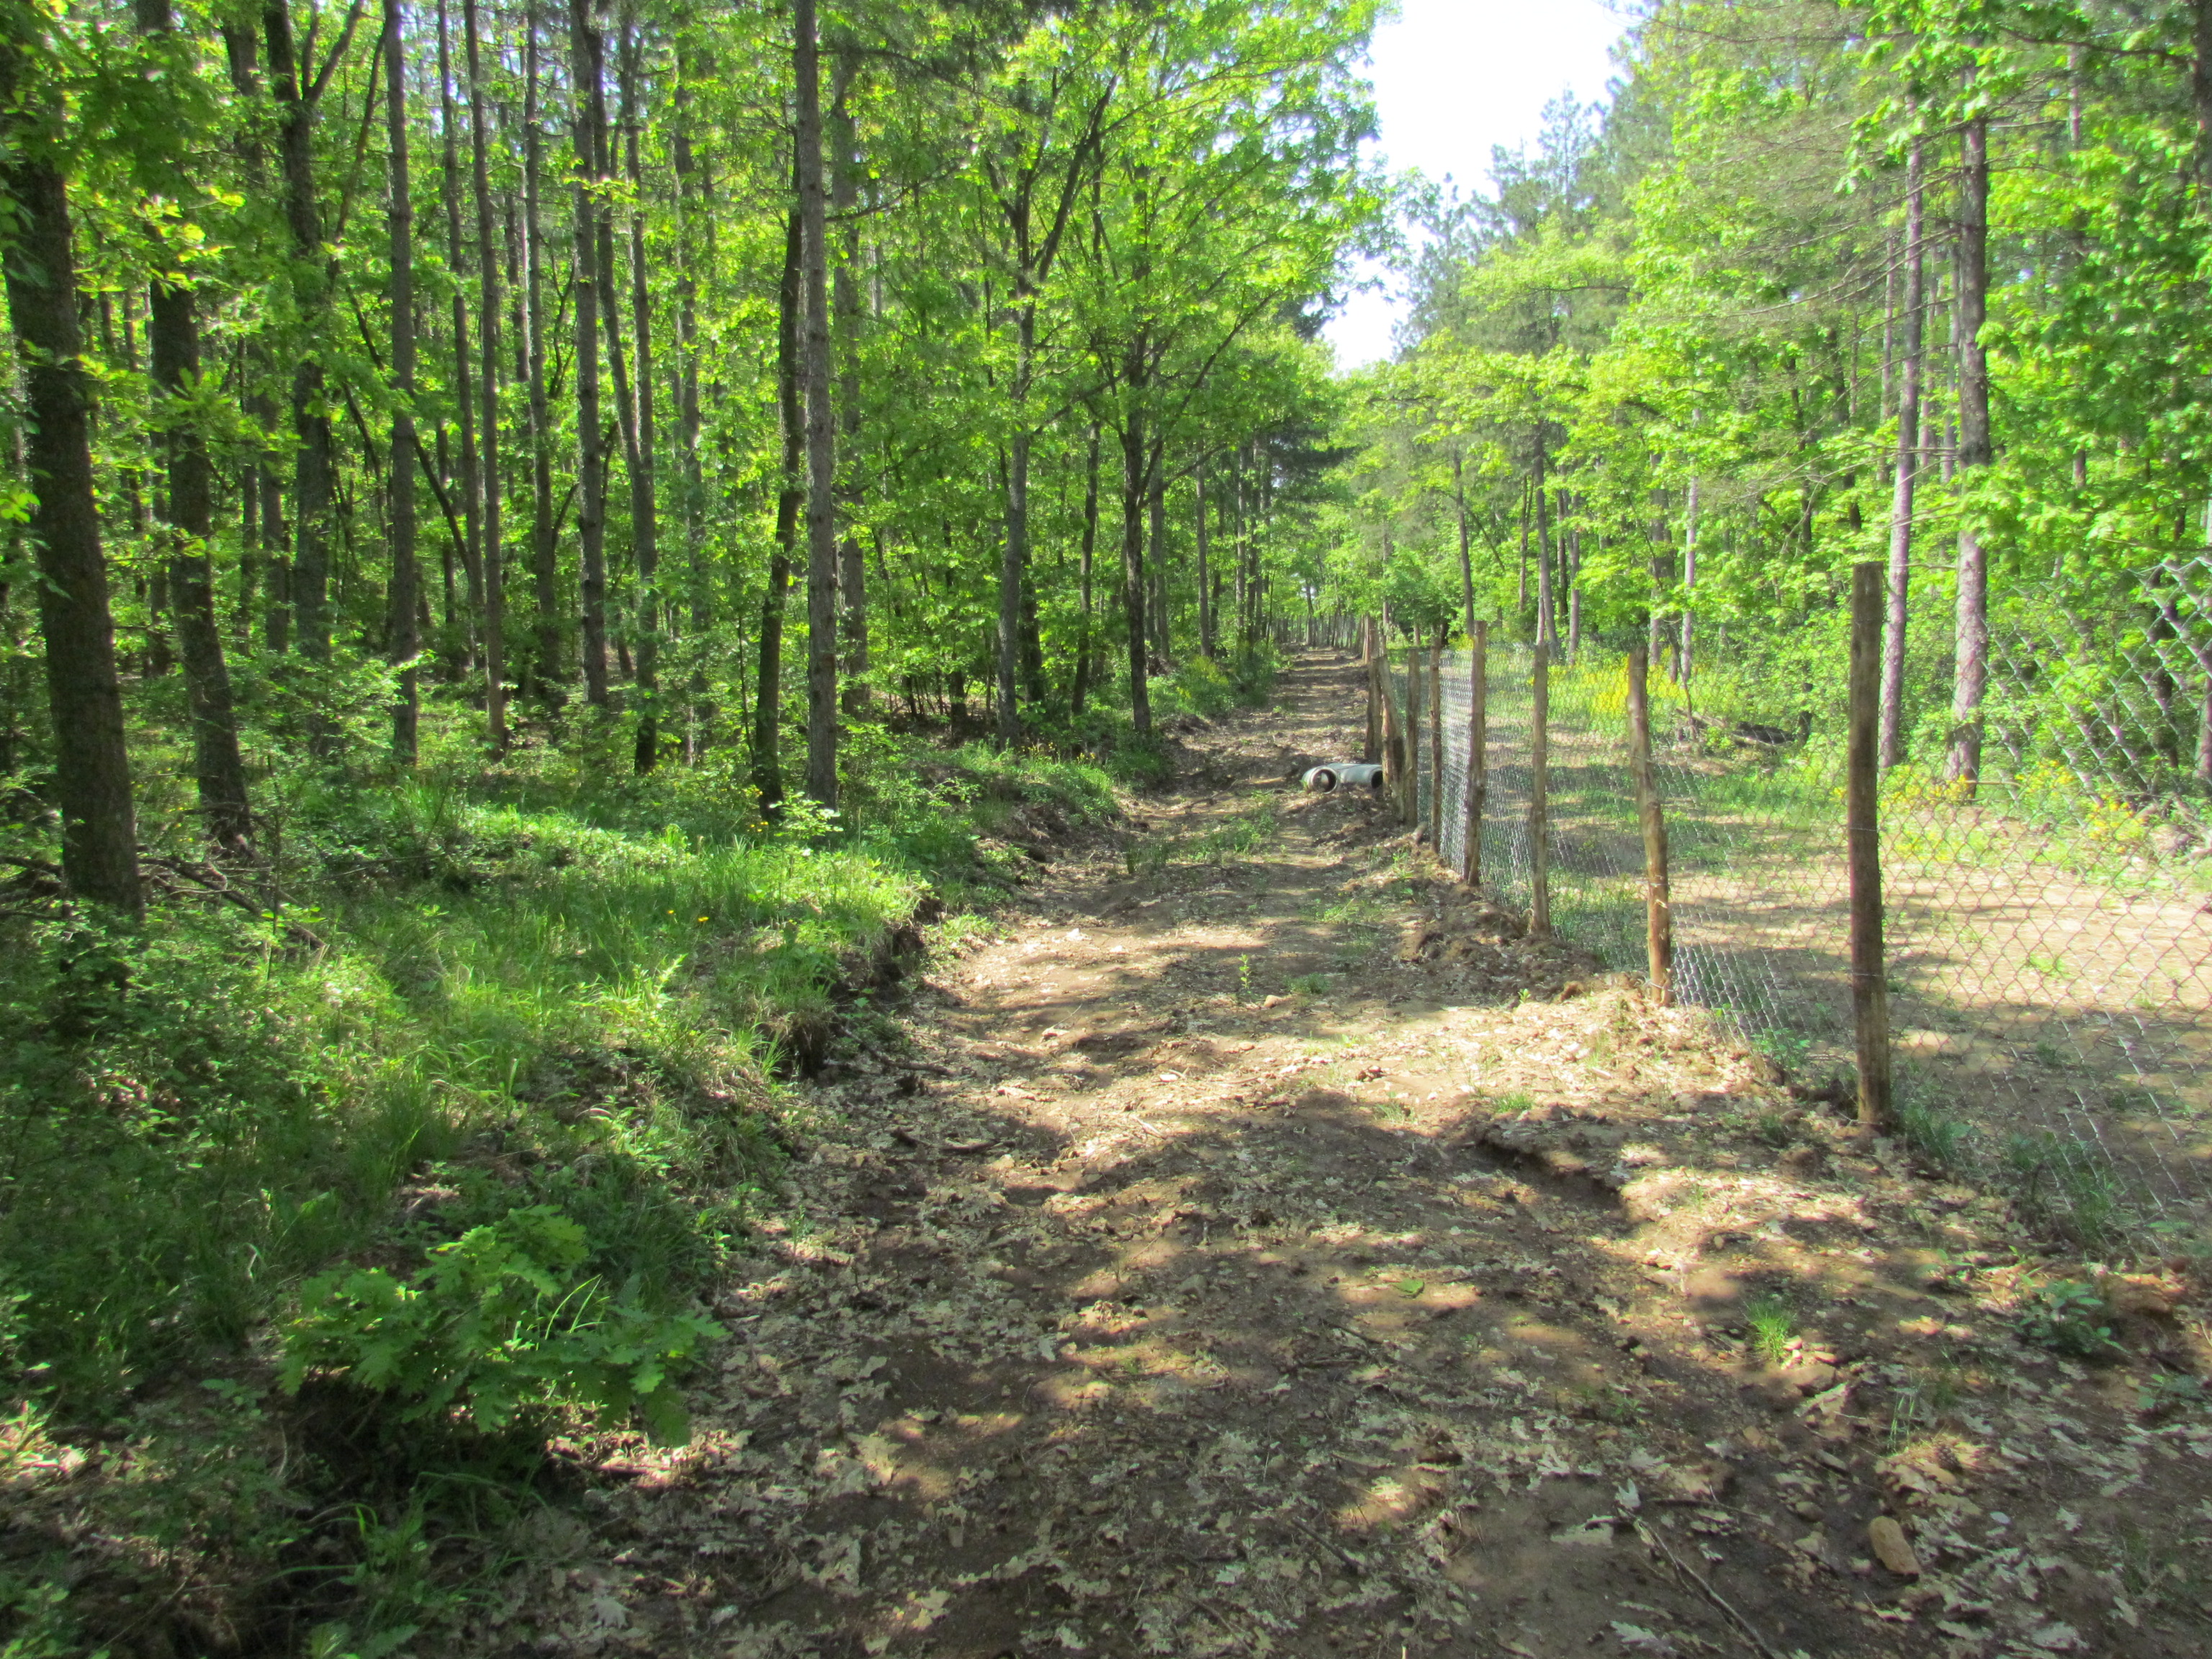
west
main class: Woodland
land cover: Pine dominated mixed woodland
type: hemiboreal forest and nemoral coniferous forest and mixed broadleaved-coniferous forest
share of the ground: > 75 %
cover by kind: broadleaved forest trees 75 %, coniferous forest trees 25 %
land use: Forestry
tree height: > 5 m
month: May
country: BG
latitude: 42.2321
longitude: 27.1286
